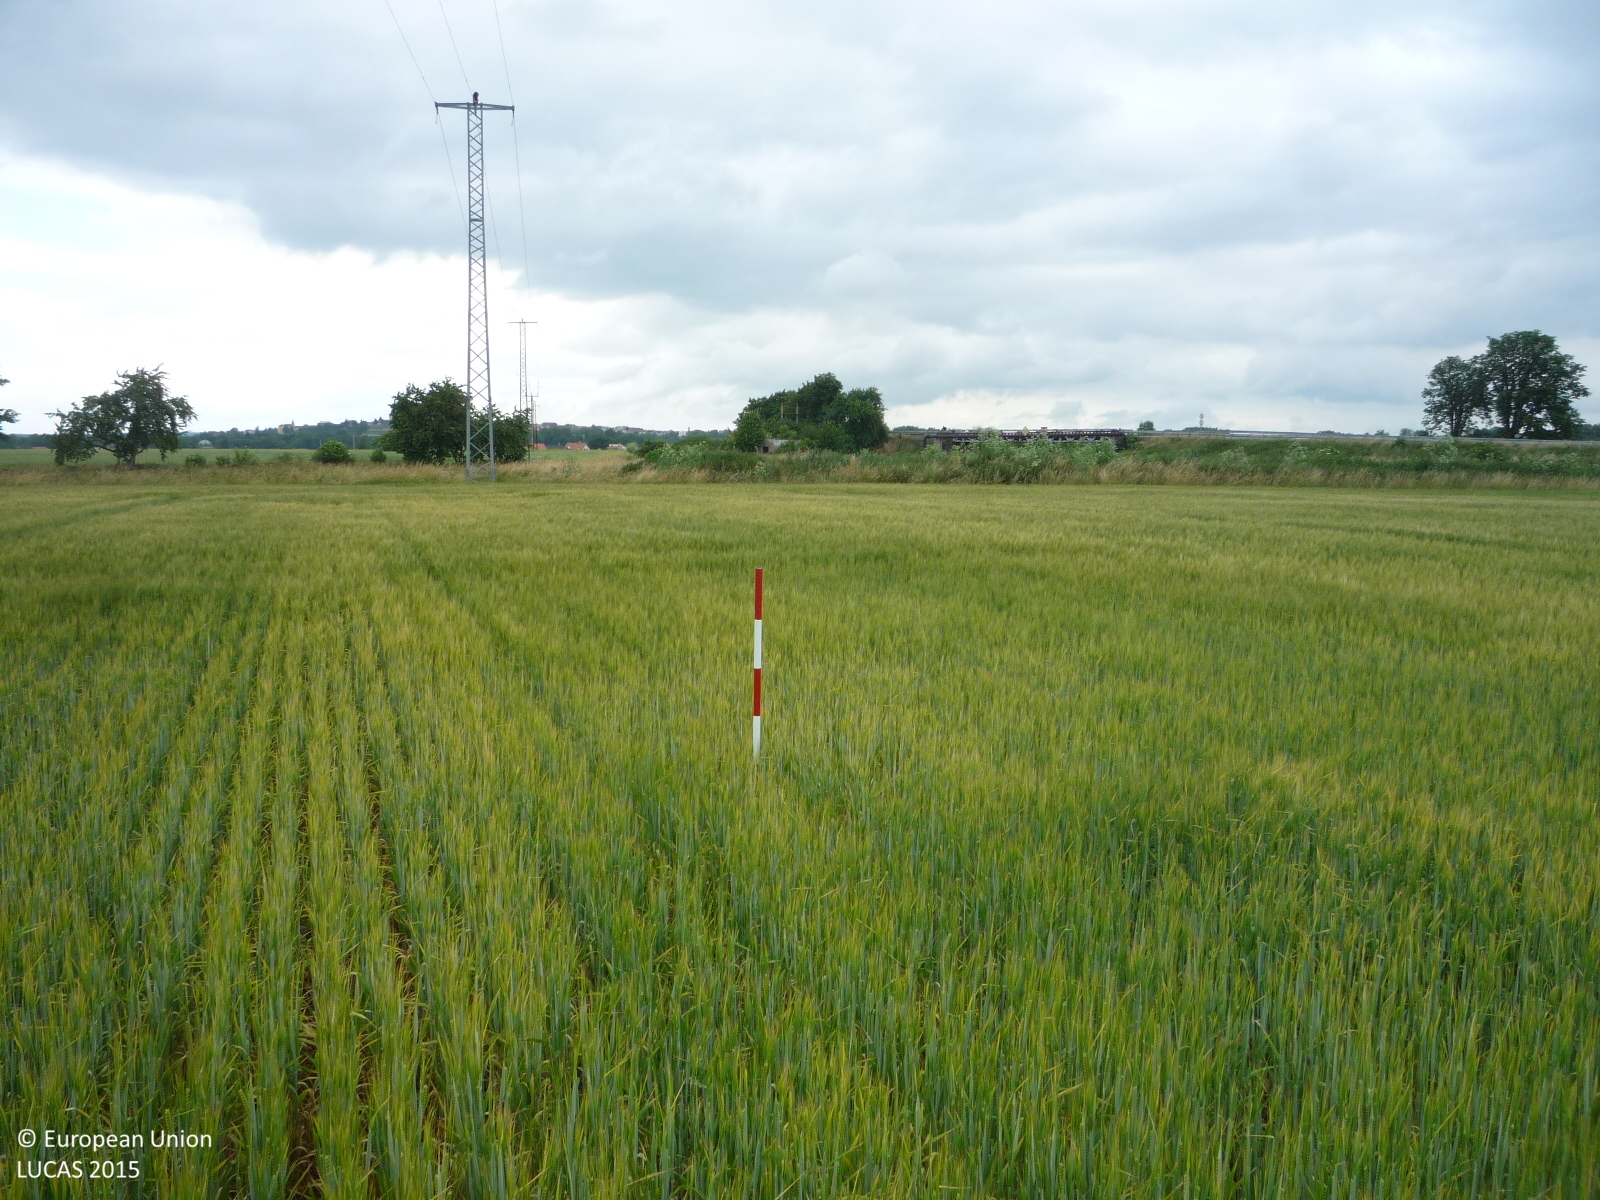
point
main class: Cropland
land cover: Barley
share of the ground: > 75 %
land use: Agriculture (excluding fallow land and kitchen gardens)
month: June
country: CZ
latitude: 50.3314
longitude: 14.4550
